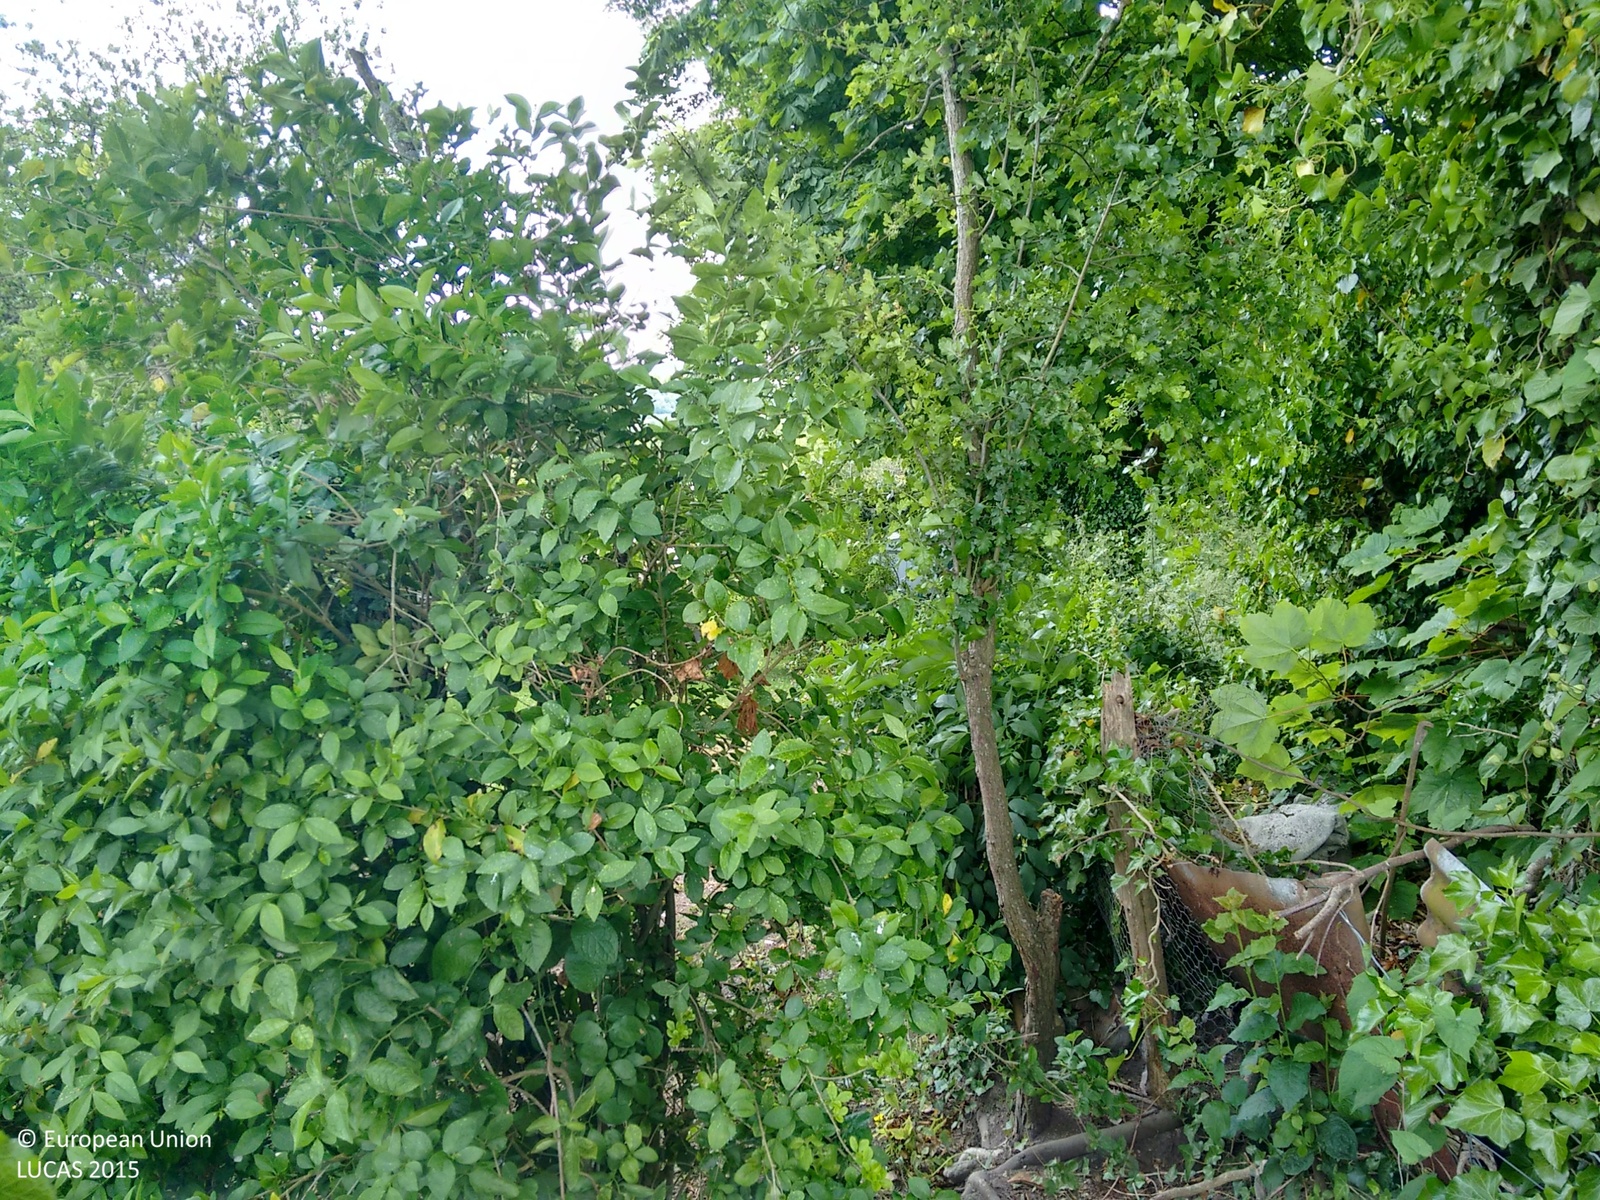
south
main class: Woodland
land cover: Broadleaved woodland
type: mesophytic deciduous forest
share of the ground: > 75 %
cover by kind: broadleaved forest trees 100 %
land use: Residential
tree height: > 5 m
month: June
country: GB
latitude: 51.0834
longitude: -1.9200
